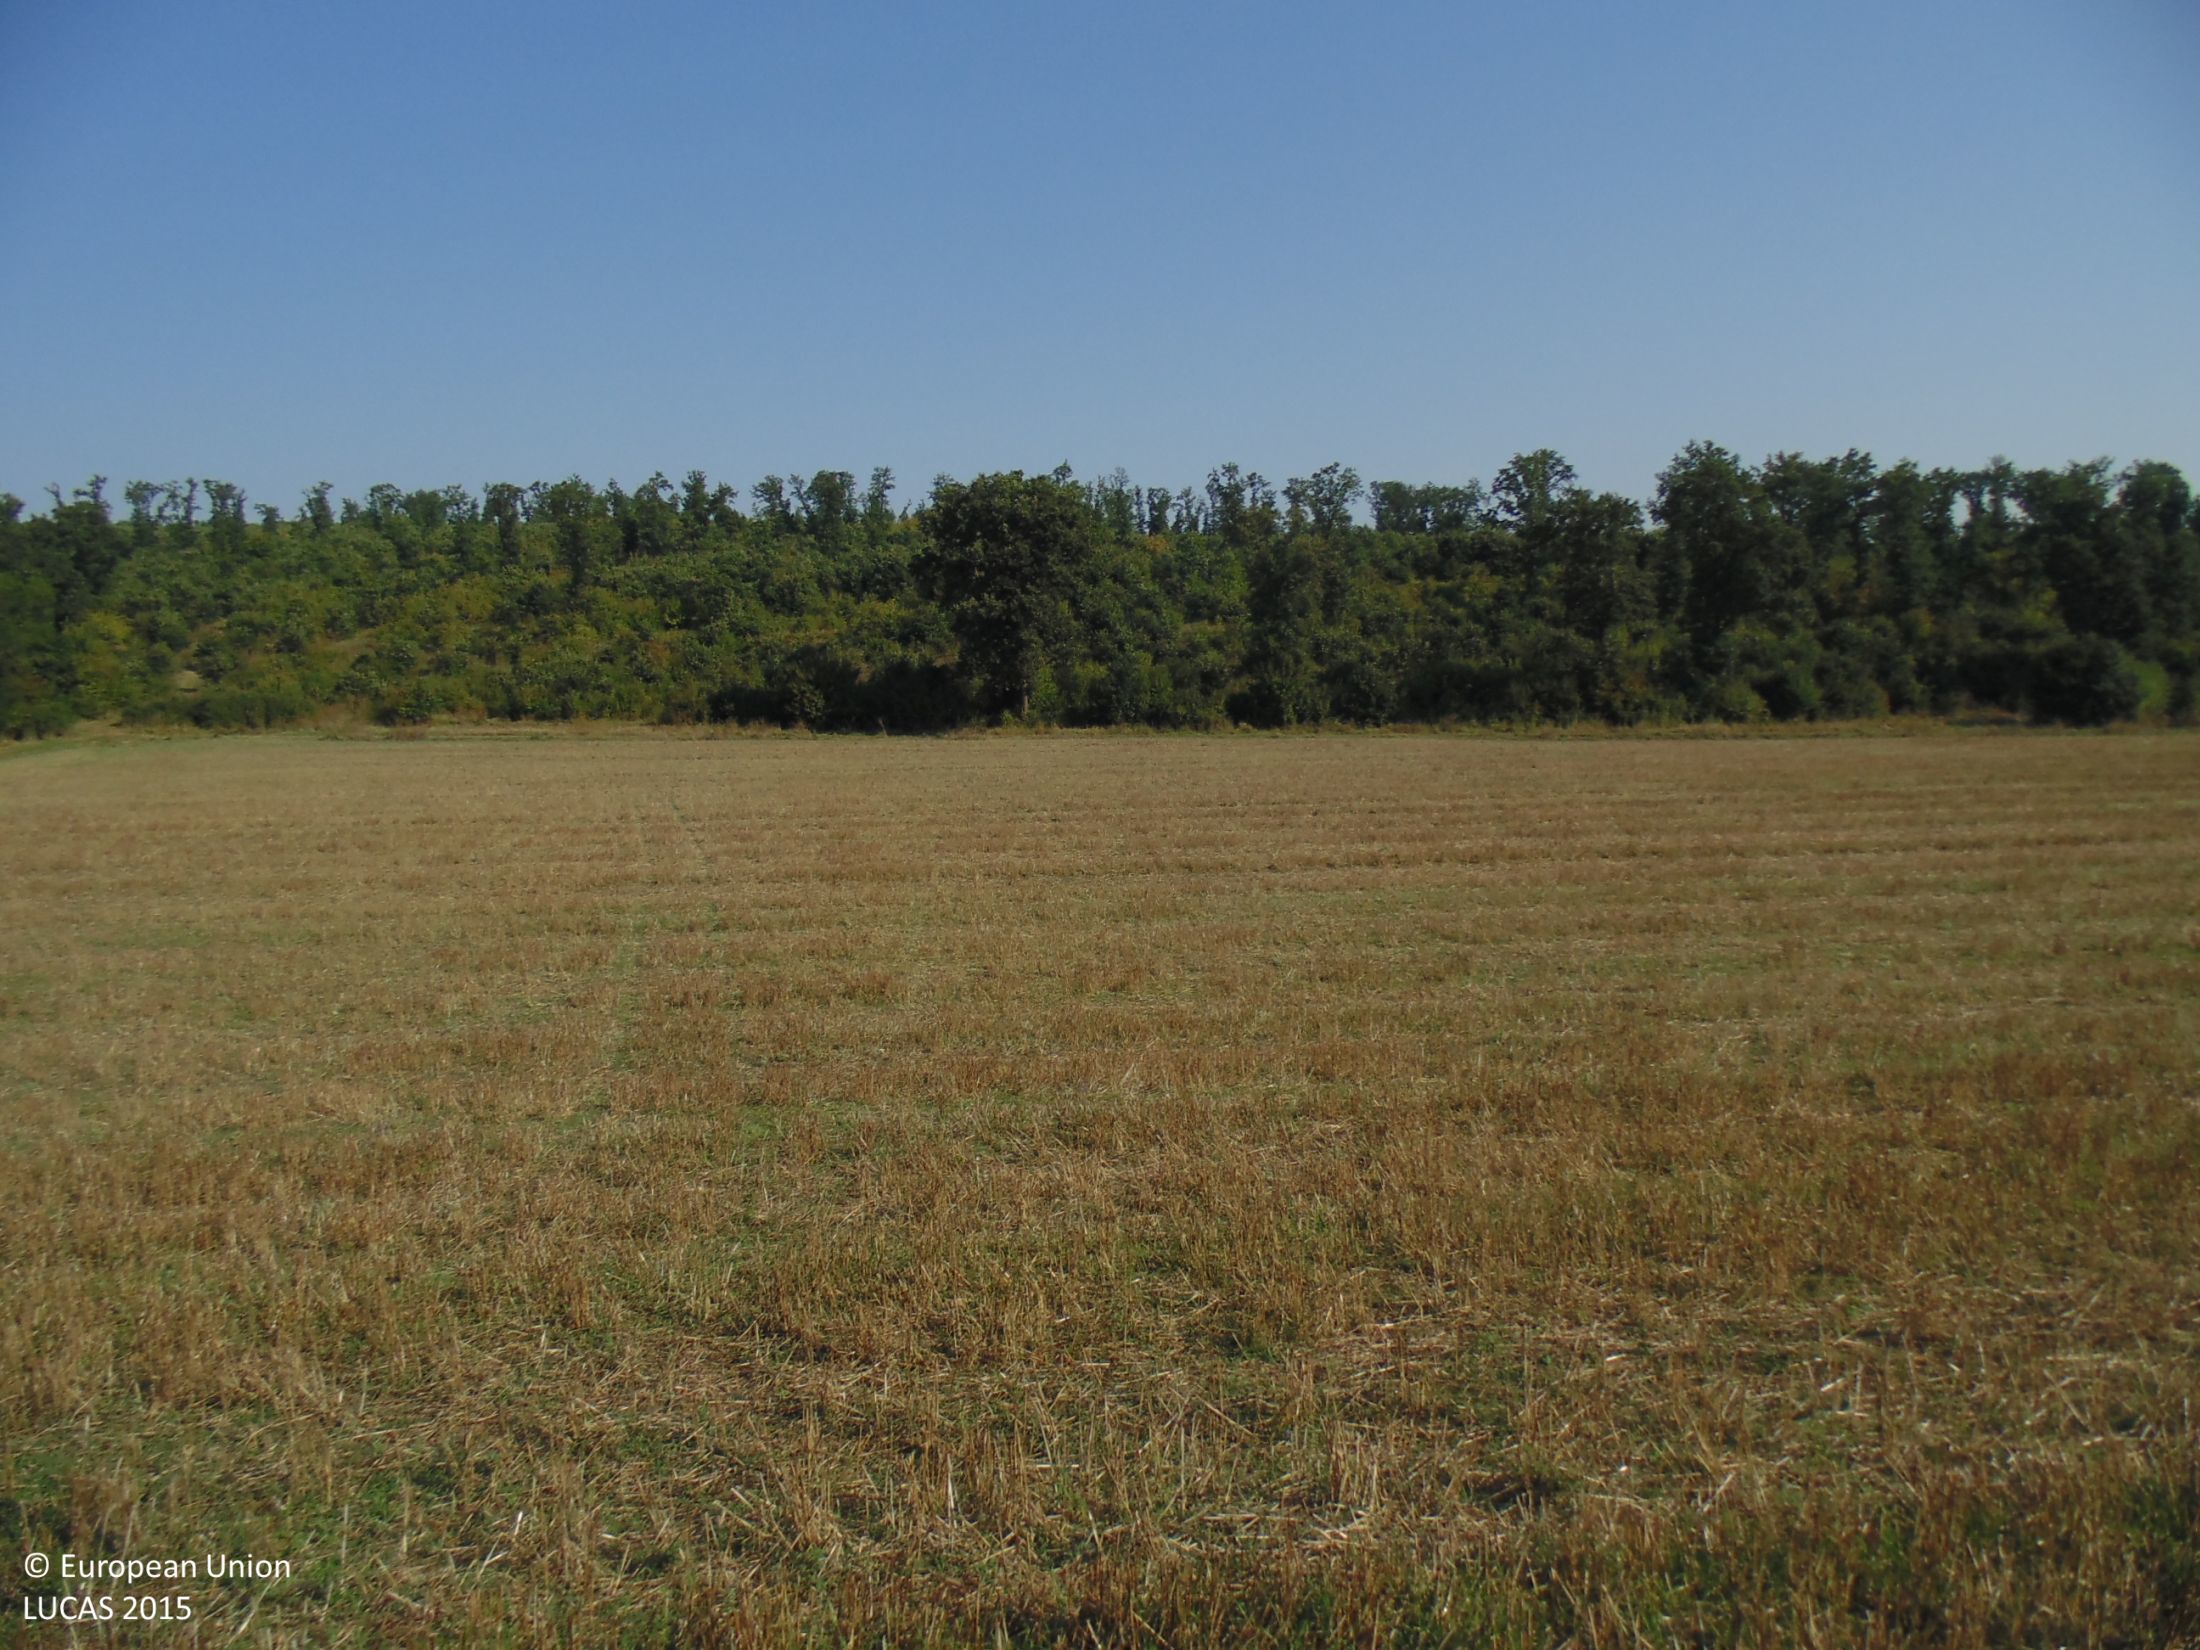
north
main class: Cropland
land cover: Common wheat
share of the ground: 25 - 50 %
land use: Agriculture (excluding fallow land and kitchen gardens)
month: September
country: BG
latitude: 43.7549
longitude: 27.0500
